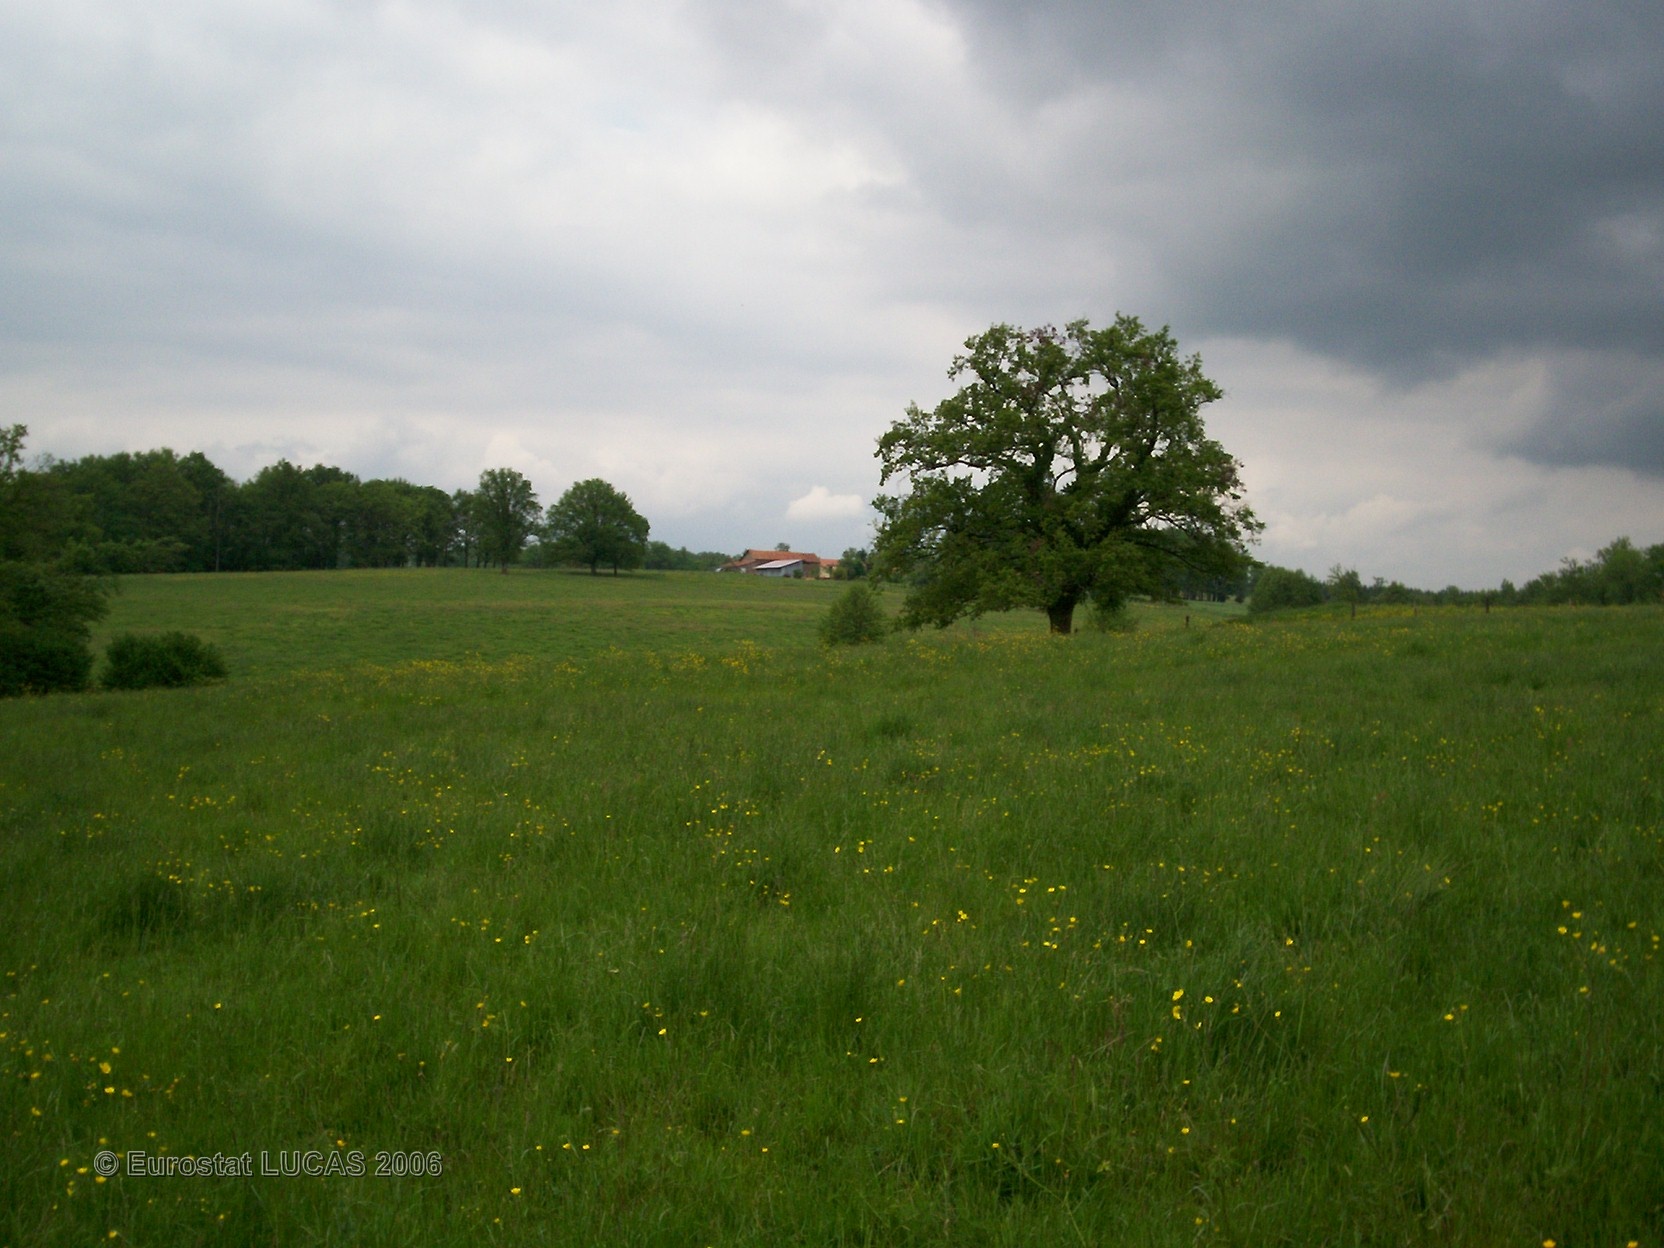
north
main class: Grassland
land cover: Grassland without tree/shrub cover
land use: Agriculture (excluding fallow land and kitchen gardens)
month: May
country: FR
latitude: 45.7162
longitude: 0.5698
